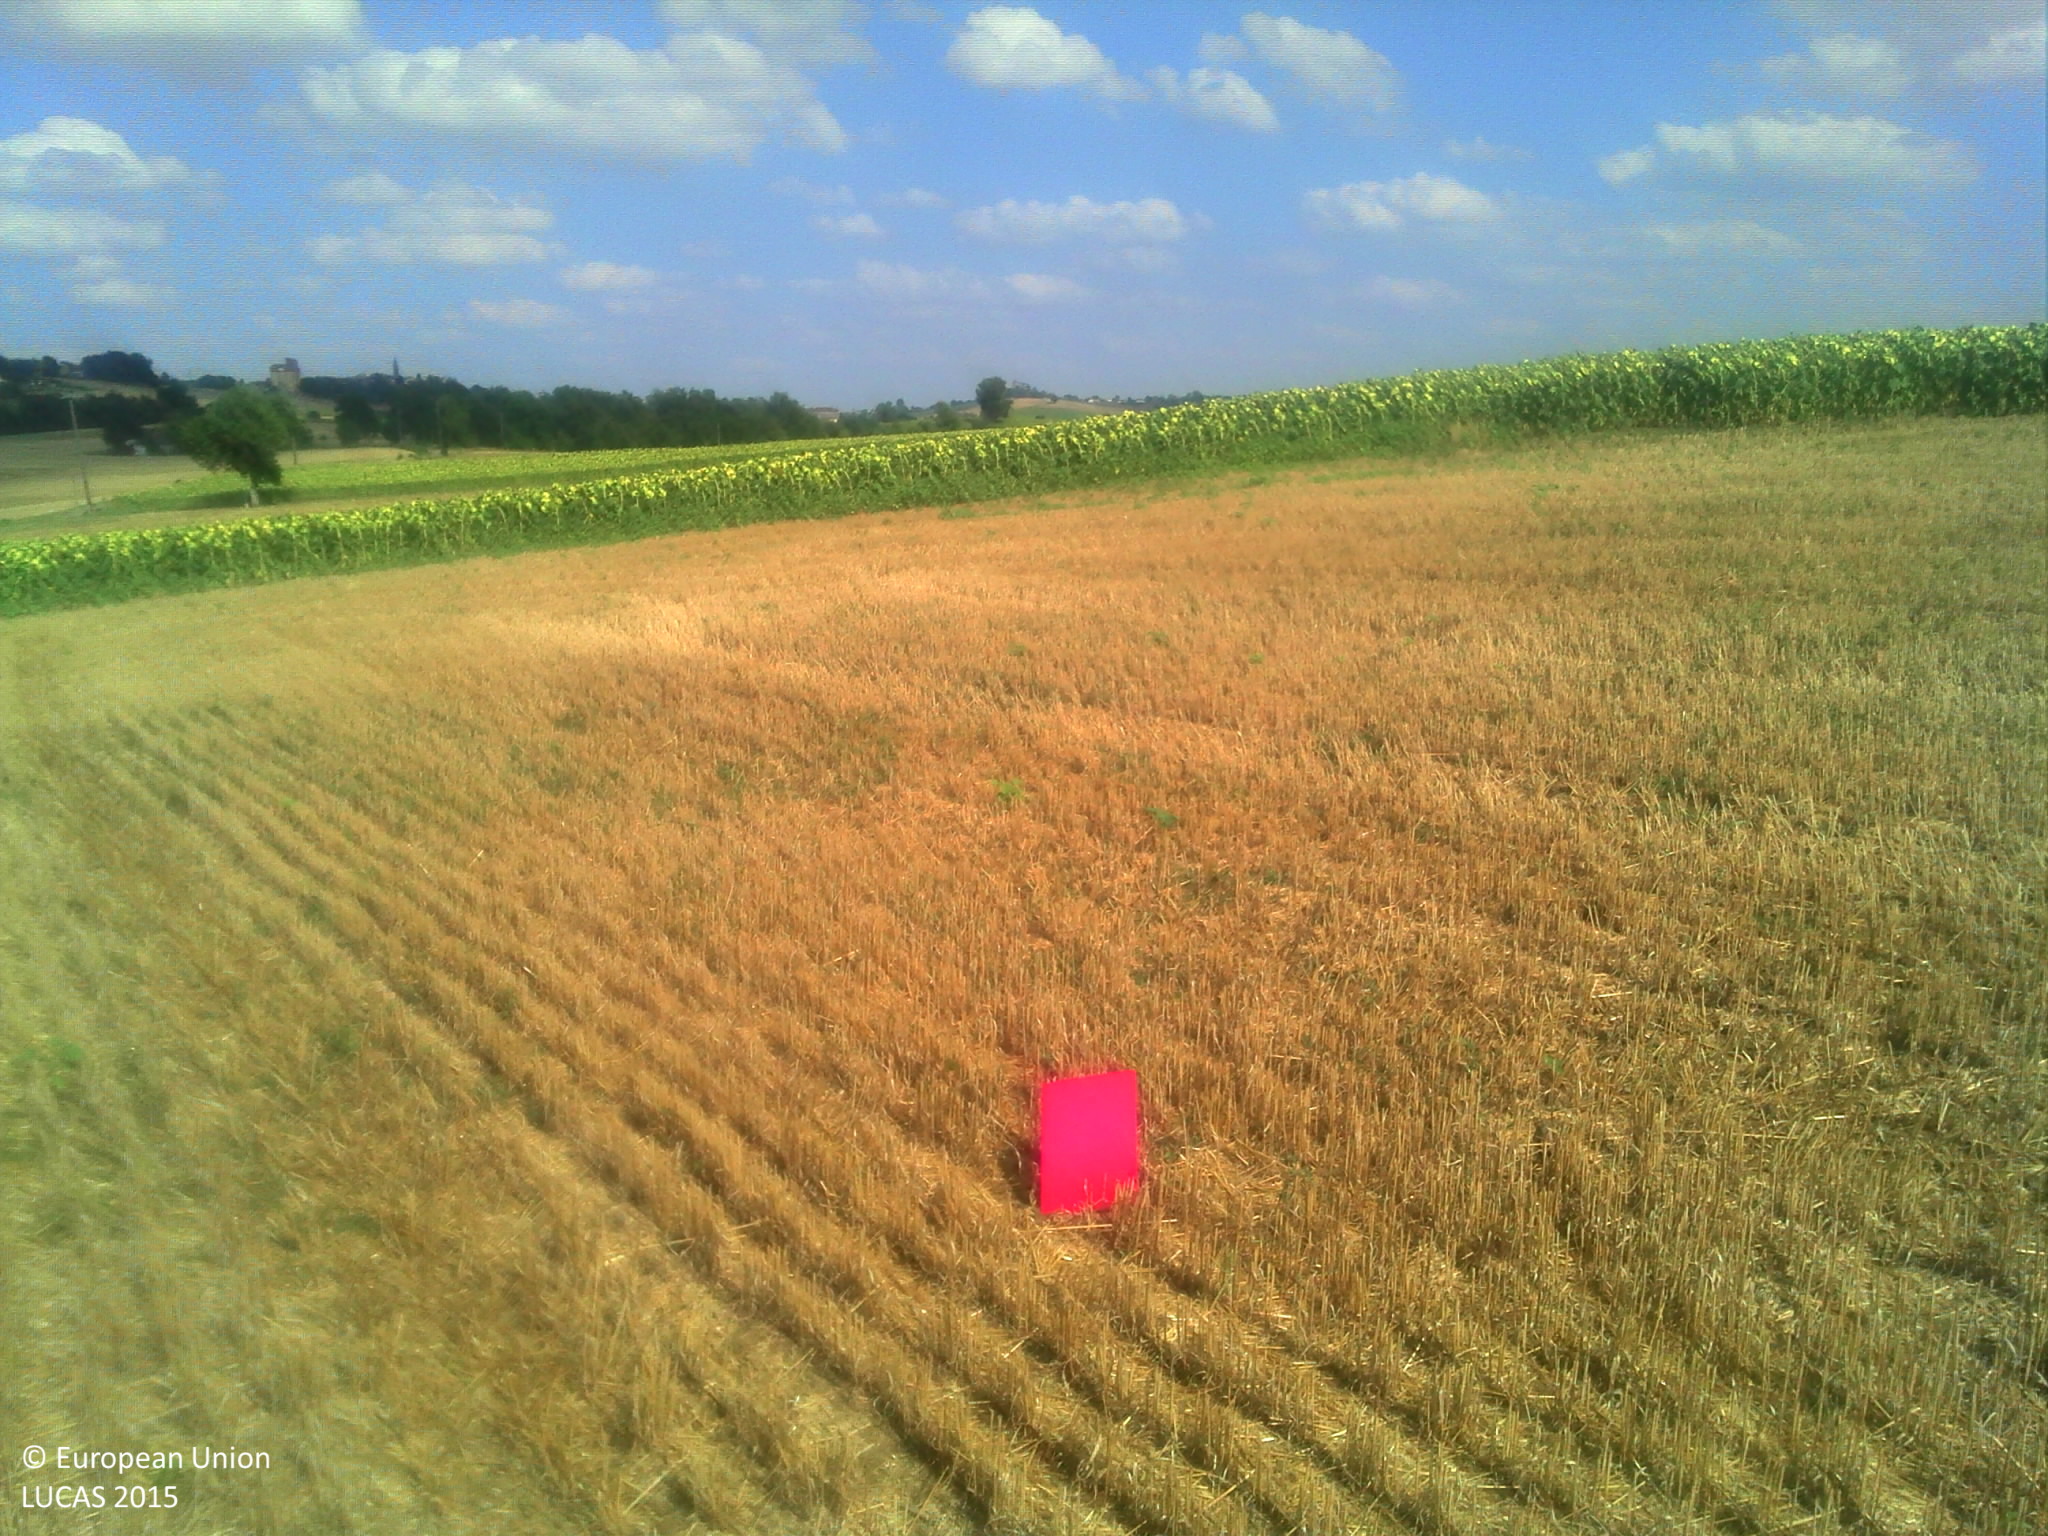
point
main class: Cropland
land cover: Common wheat
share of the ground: > 75 %
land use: Agriculture (excluding fallow land and kitchen gardens)
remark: Harvested field
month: July
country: FR
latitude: 44.0163
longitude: 0.6276
